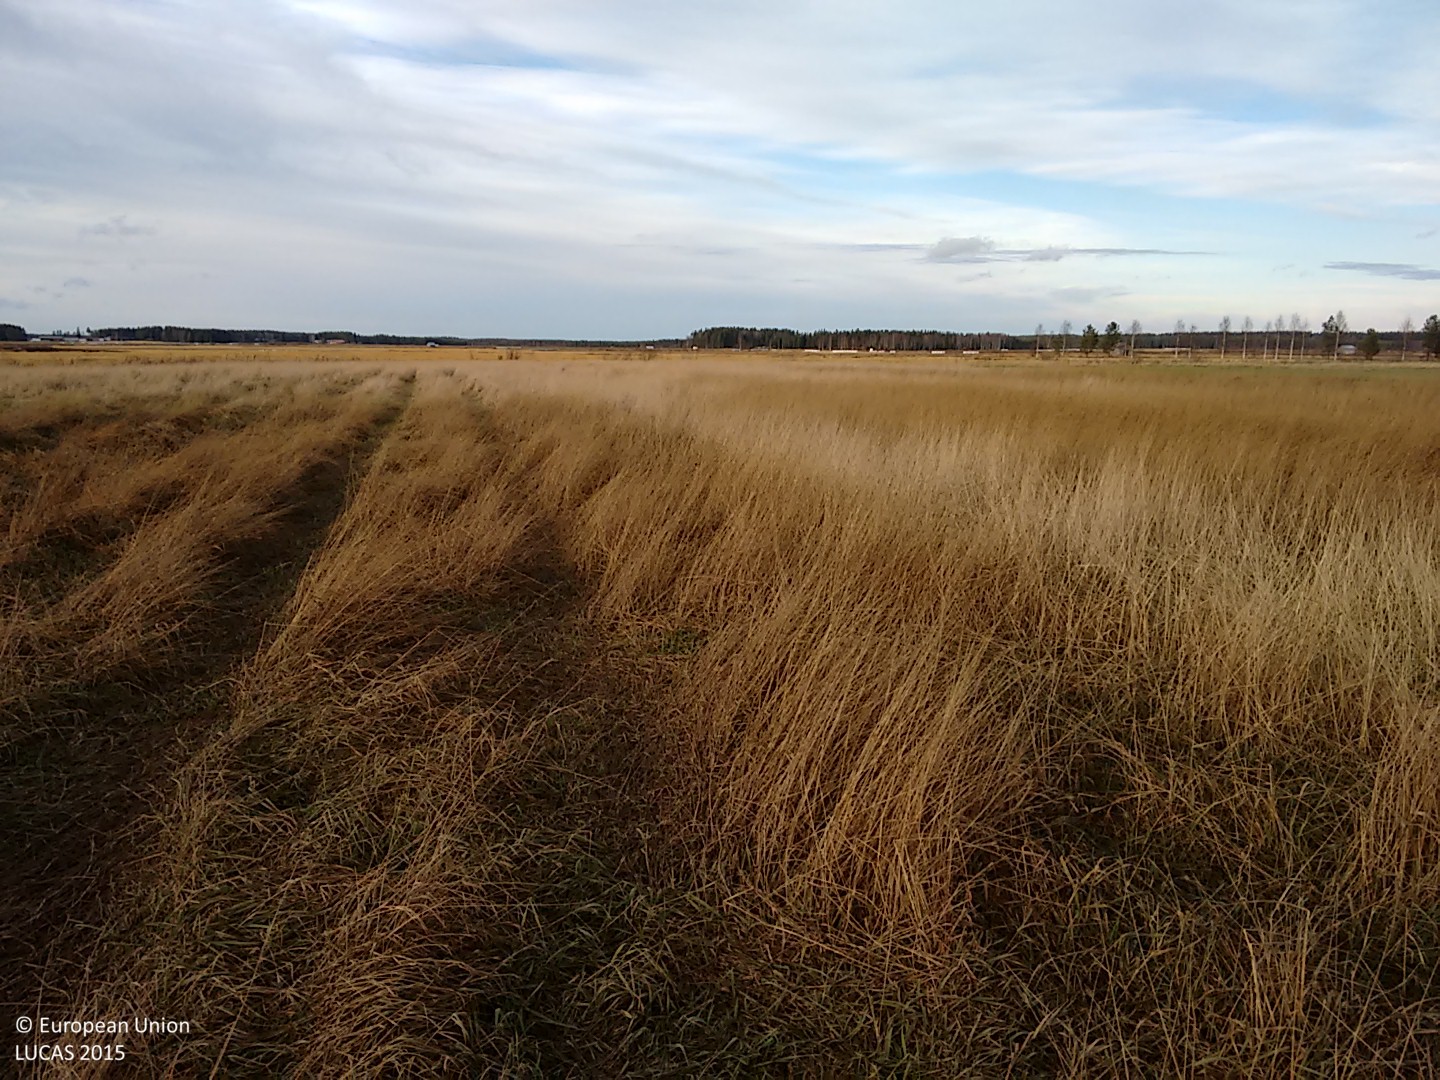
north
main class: Cropland
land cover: Temporary grasslands
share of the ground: > 75 %
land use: Agriculture (excluding fallow land and kitchen gardens)
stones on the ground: < 10 %
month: October
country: FI
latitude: 63.9478
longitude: 25.0869
